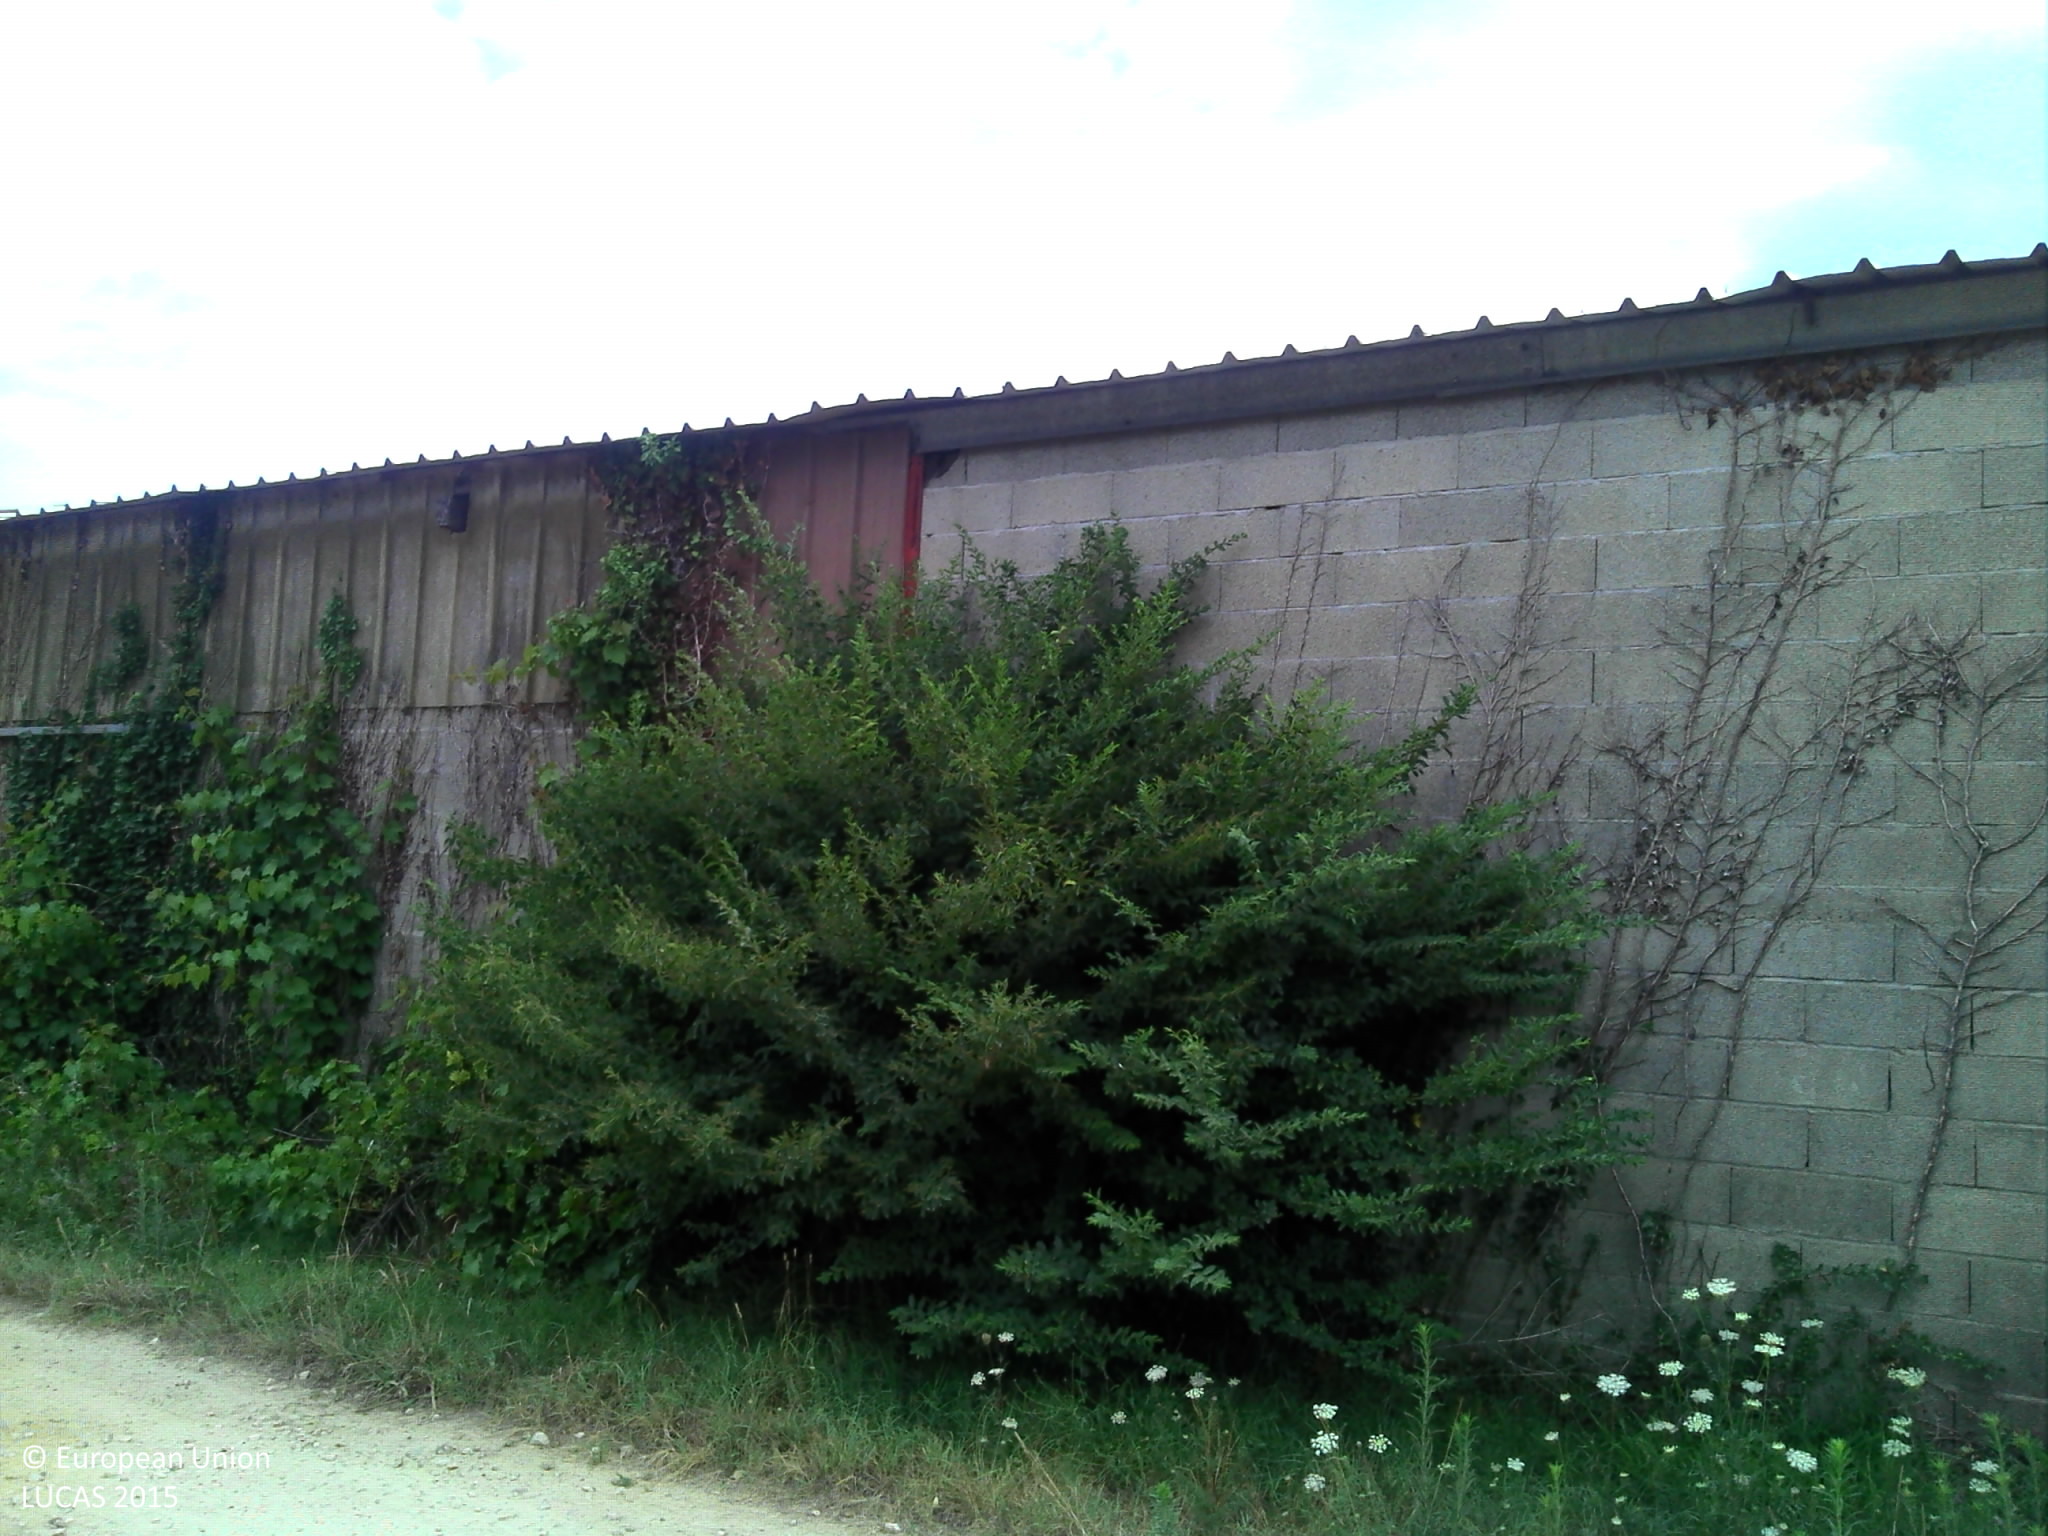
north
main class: Grassland
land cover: Grassland without tree/shrub cover
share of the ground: > 75 %
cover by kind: herbaceous plants 100 %
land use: Agriculture (excluding fallow land and kitchen gardens)
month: July
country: FR
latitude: 43.8196
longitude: -0.8187
